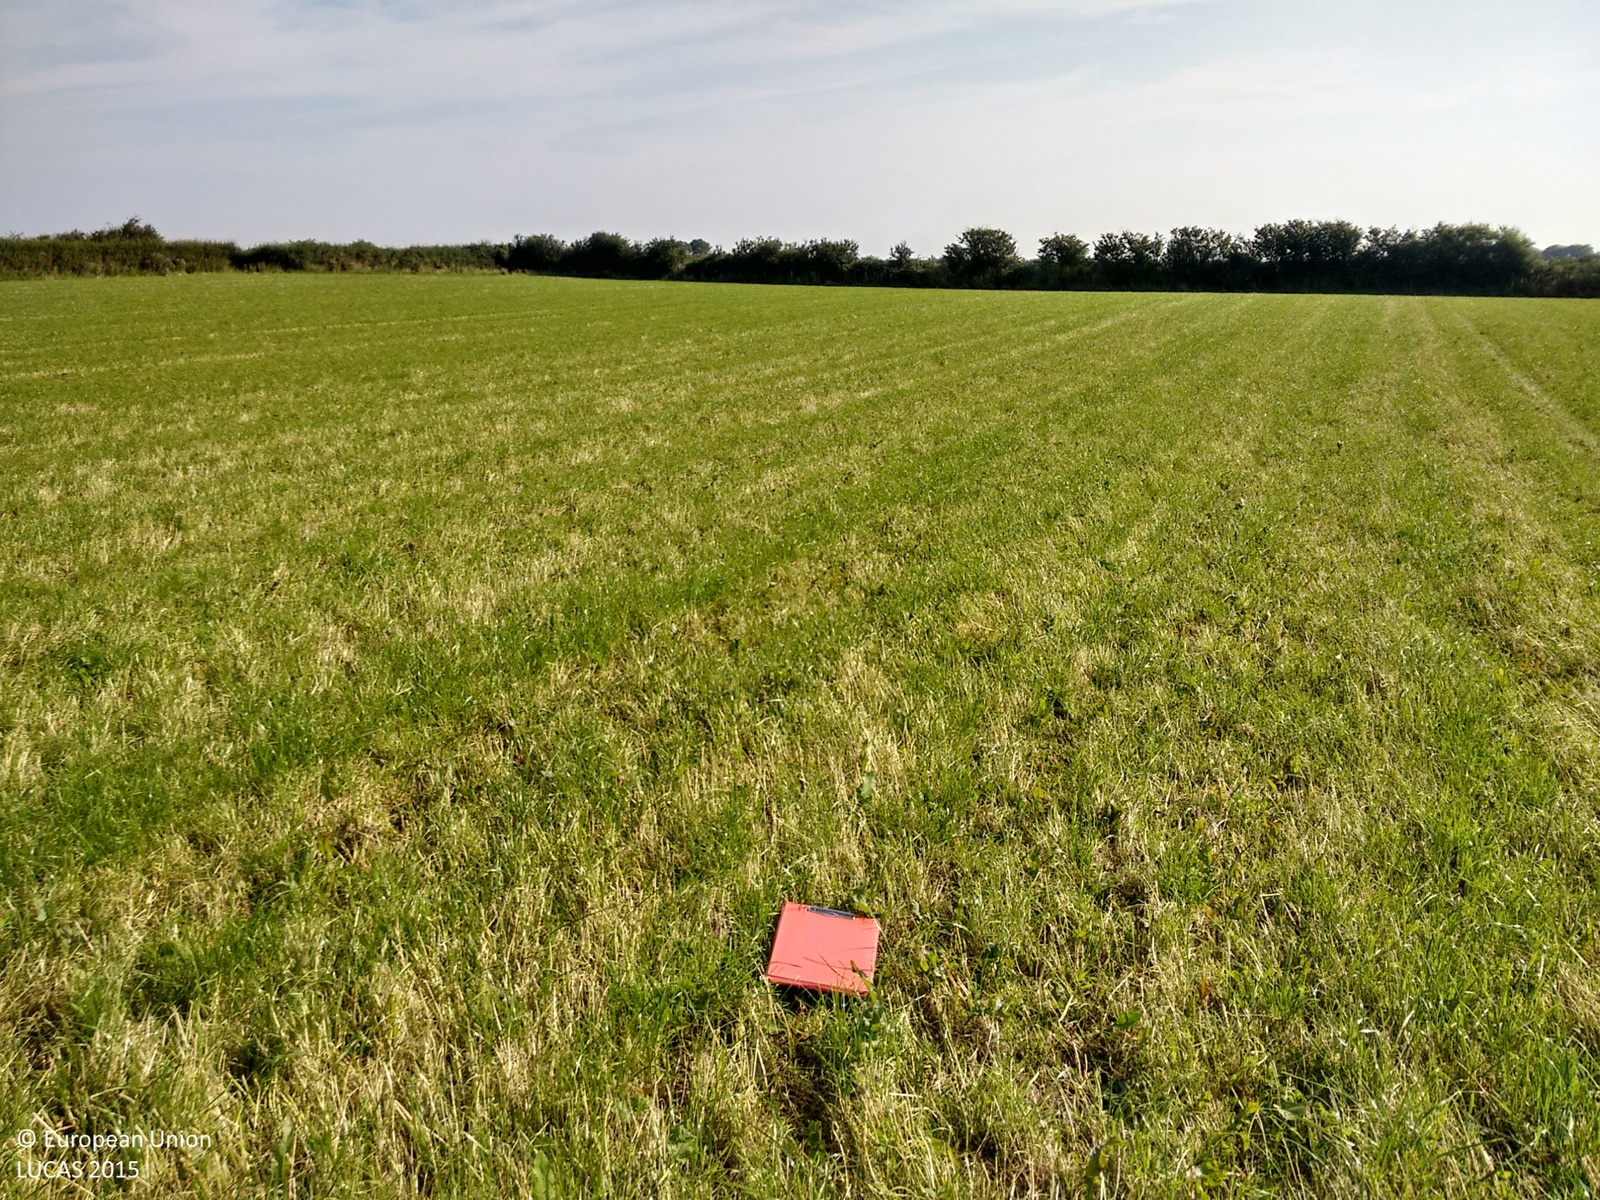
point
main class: Cropland
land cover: Temporary grasslands
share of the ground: > 75 %
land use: Agriculture (excluding fallow land and kitchen gardens)
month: August
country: GB
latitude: 54.8382
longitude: -3.2646
